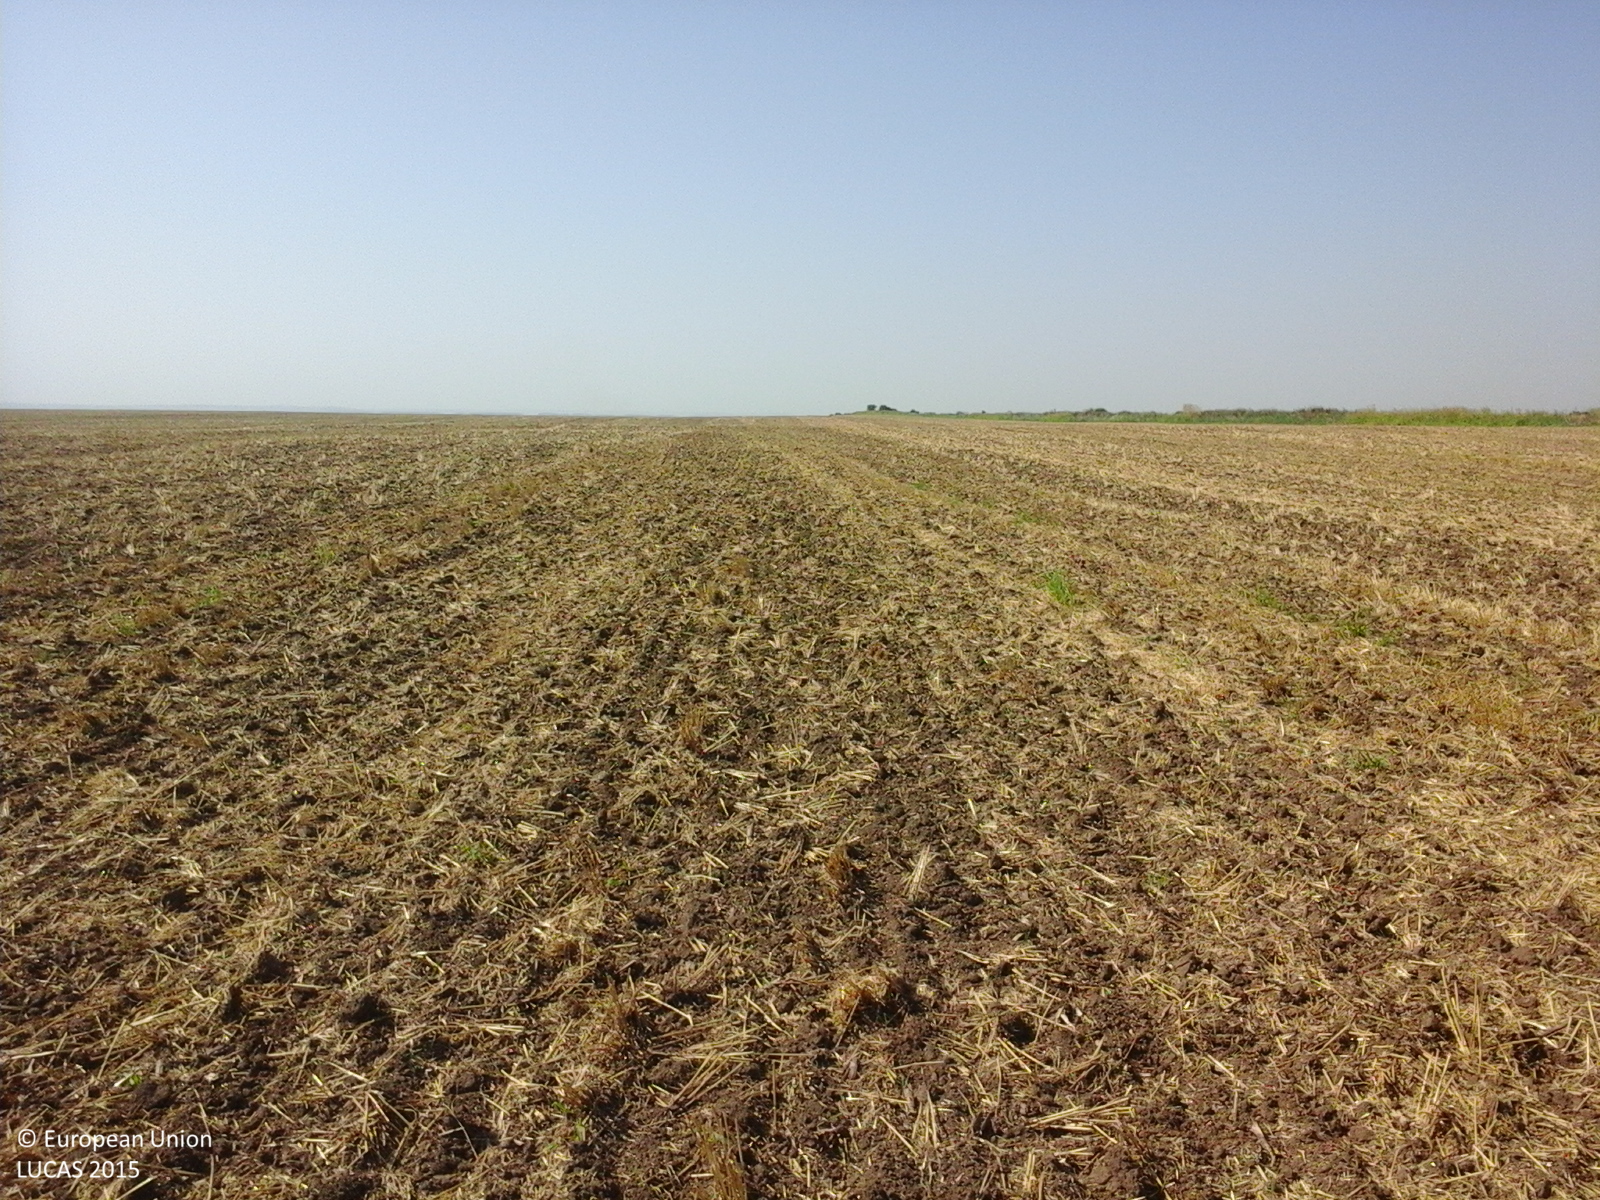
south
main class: Cropland
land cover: Common wheat
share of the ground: 10 - 25 %
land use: Agriculture (excluding fallow land and kitchen gardens)
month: July
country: RO
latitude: 44.3126
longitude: 27.4529
